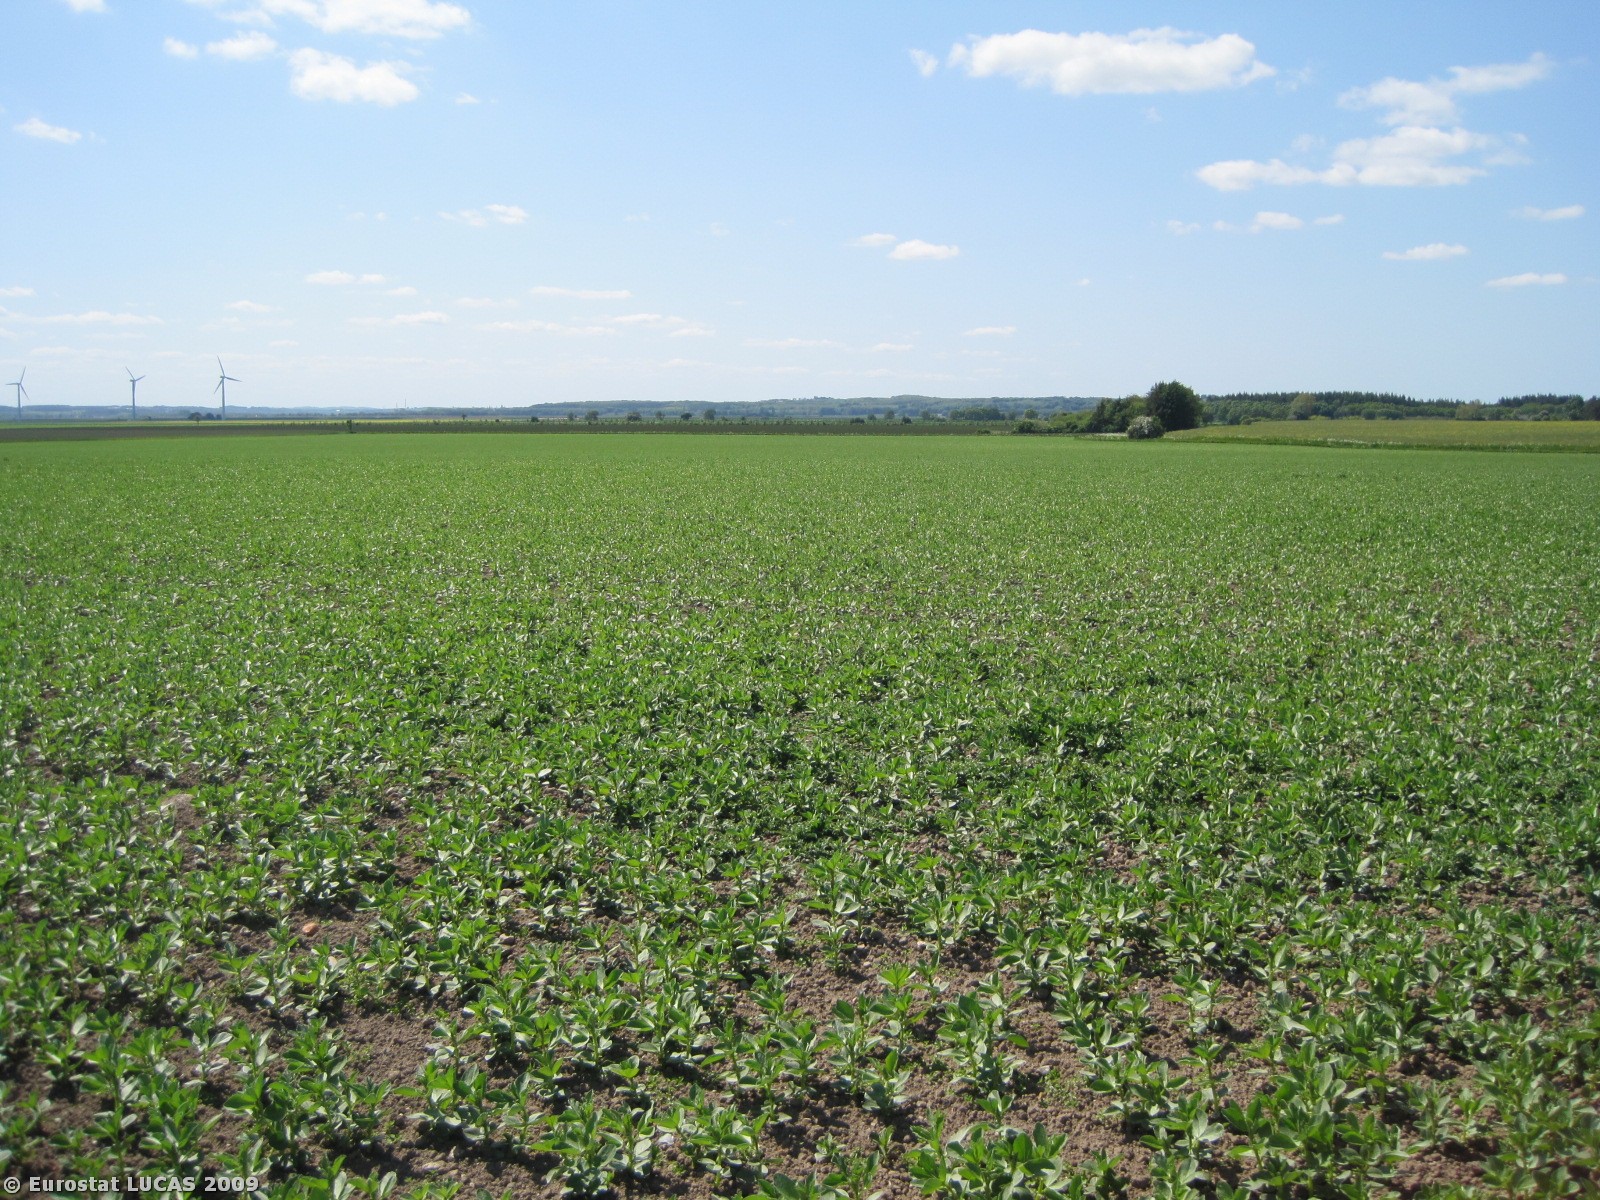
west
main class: Cropland
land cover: Dry pulses
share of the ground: 25 - 50 %
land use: Agriculture (excluding fallow land and kitchen gardens)
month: May
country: DK
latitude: 56.5110
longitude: 10.2759
